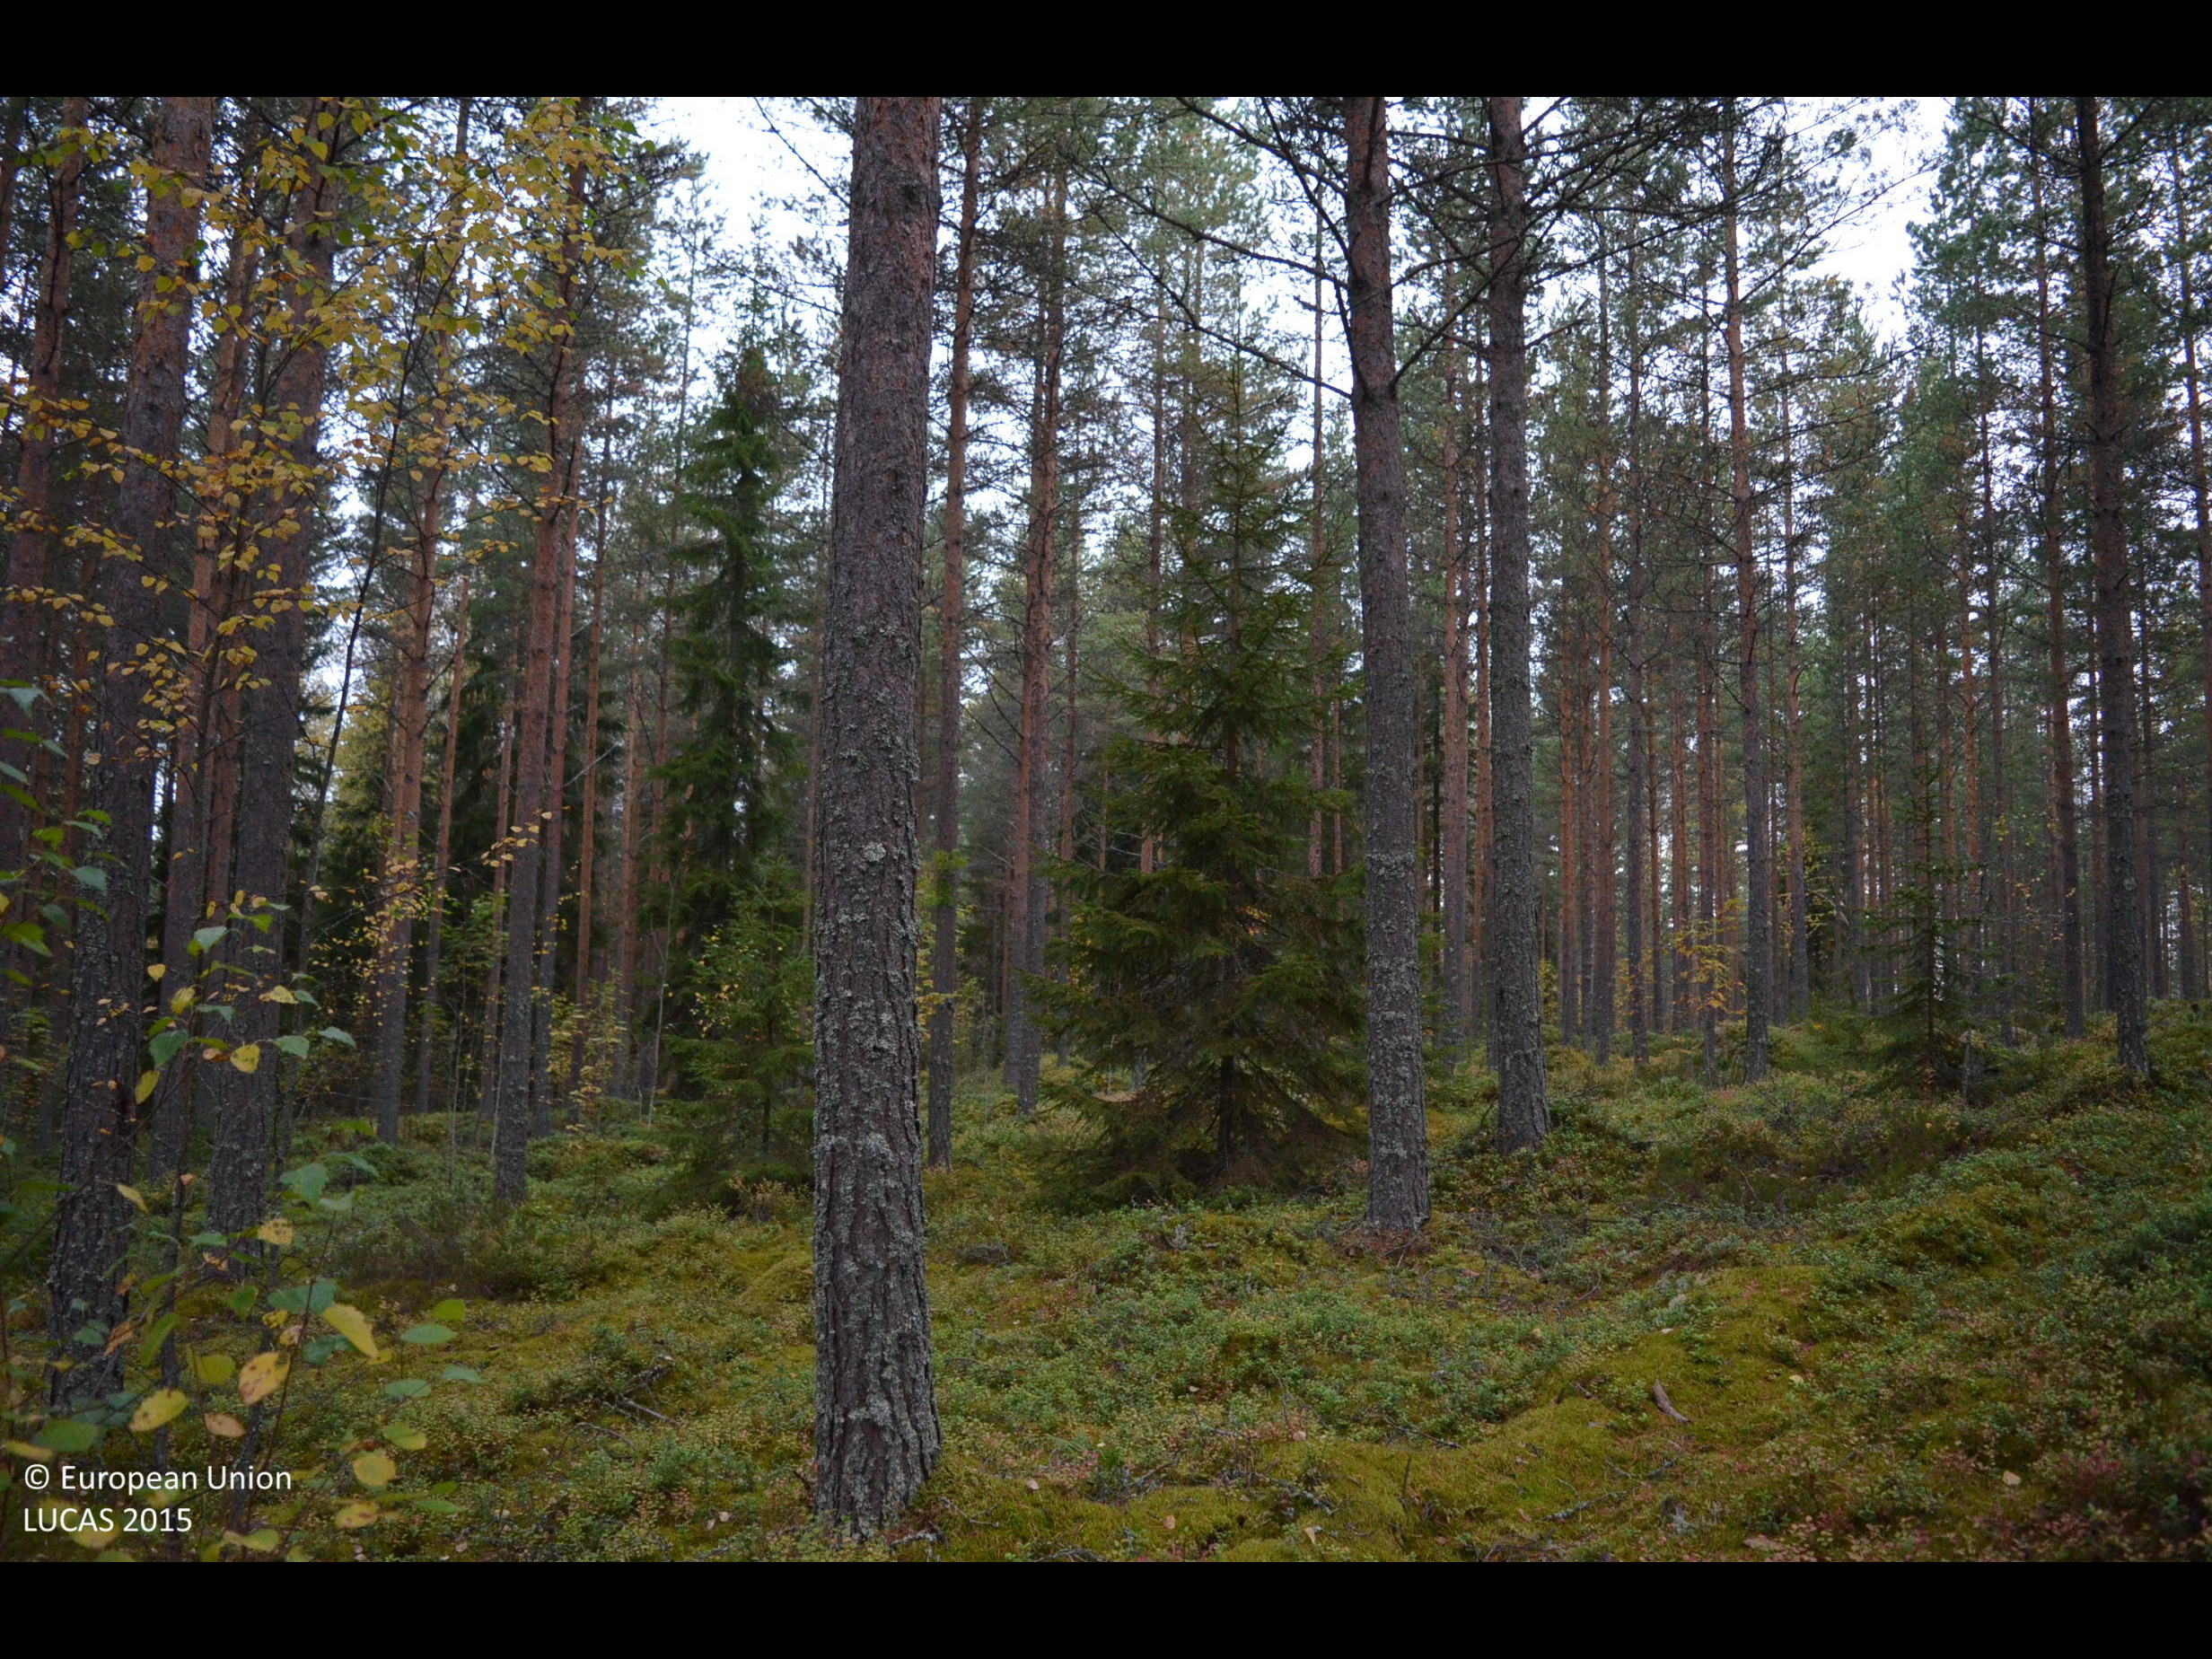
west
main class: Woodland
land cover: Pine dominated coniferous woodland
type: boreal forest
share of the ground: 50 - 75 %
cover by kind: coniferous forest trees 65 %, shrubs 25 %, broadleaved forest trees 5 %, lichens and mosses 5 %
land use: Forestry
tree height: > 5 m
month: September
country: FI
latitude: 62.5894
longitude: 23.6836
